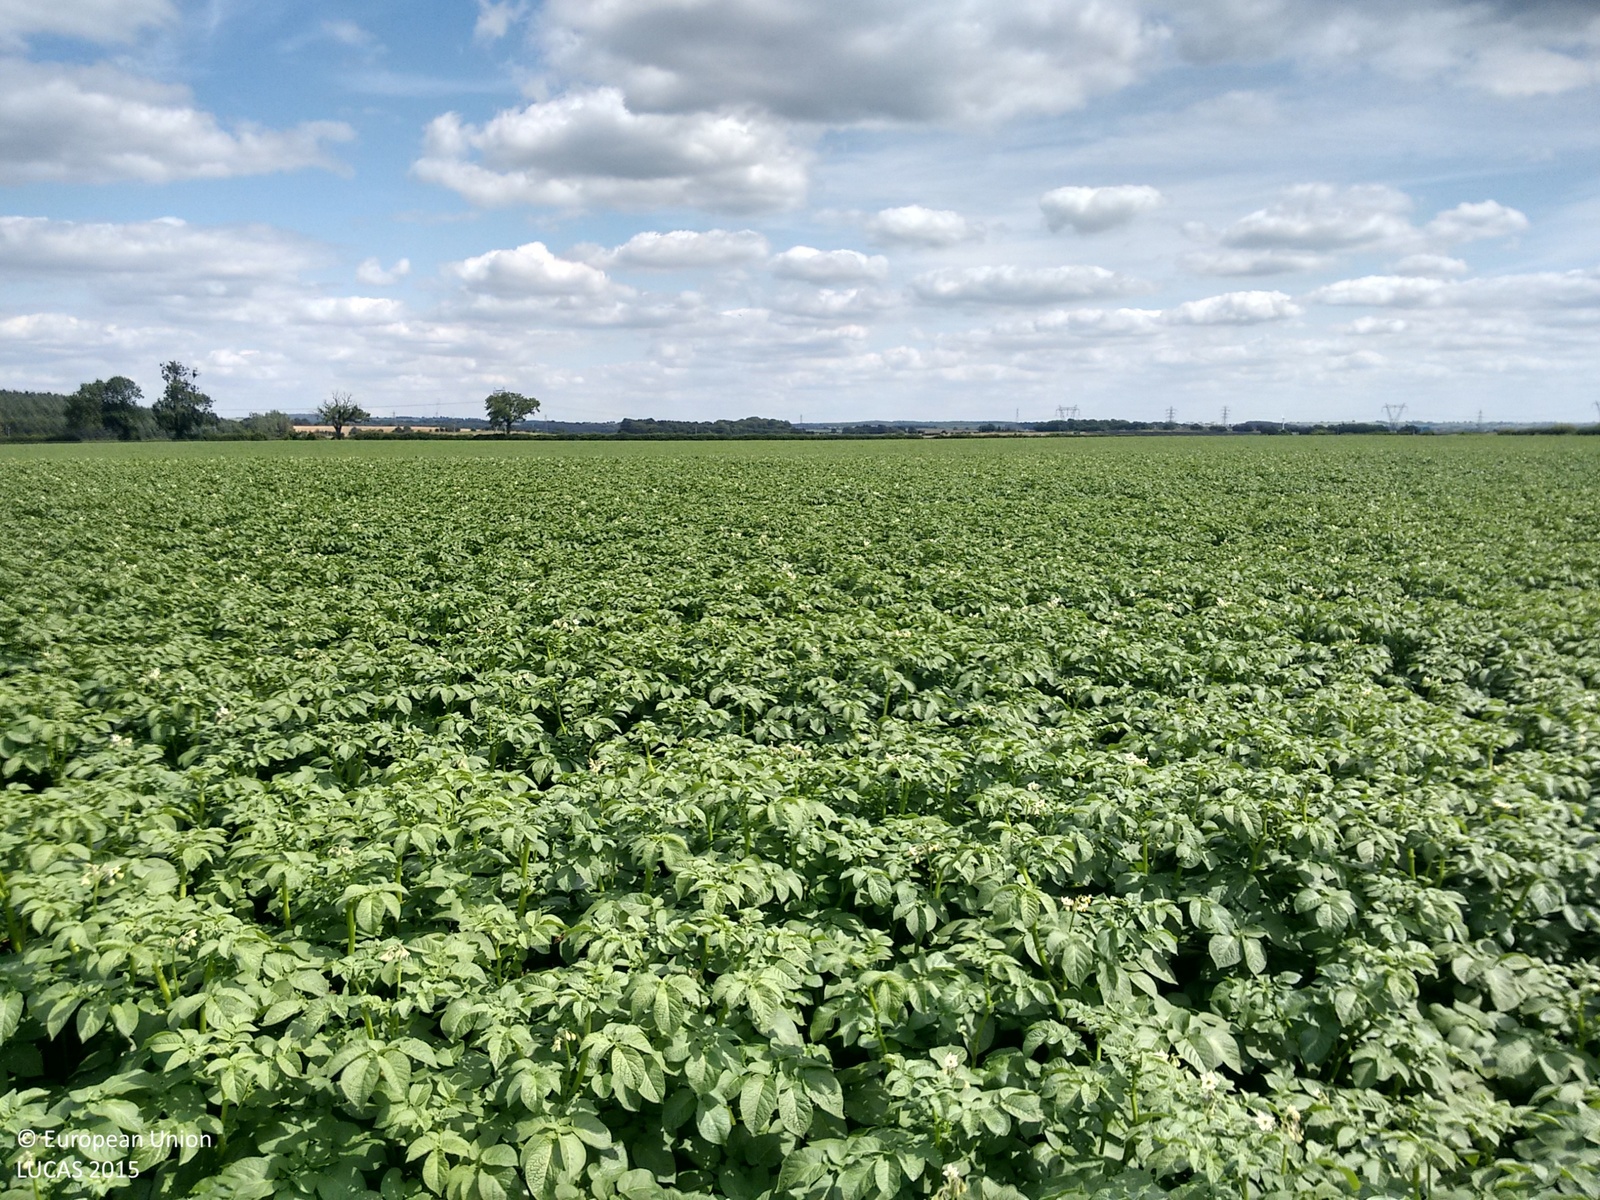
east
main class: Cropland
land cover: Potatoes
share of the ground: > 75 %
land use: Agriculture (excluding fallow land and kitchen gardens)
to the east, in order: Potatoes
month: July
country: GB
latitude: 53.3151
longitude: -1.0162
